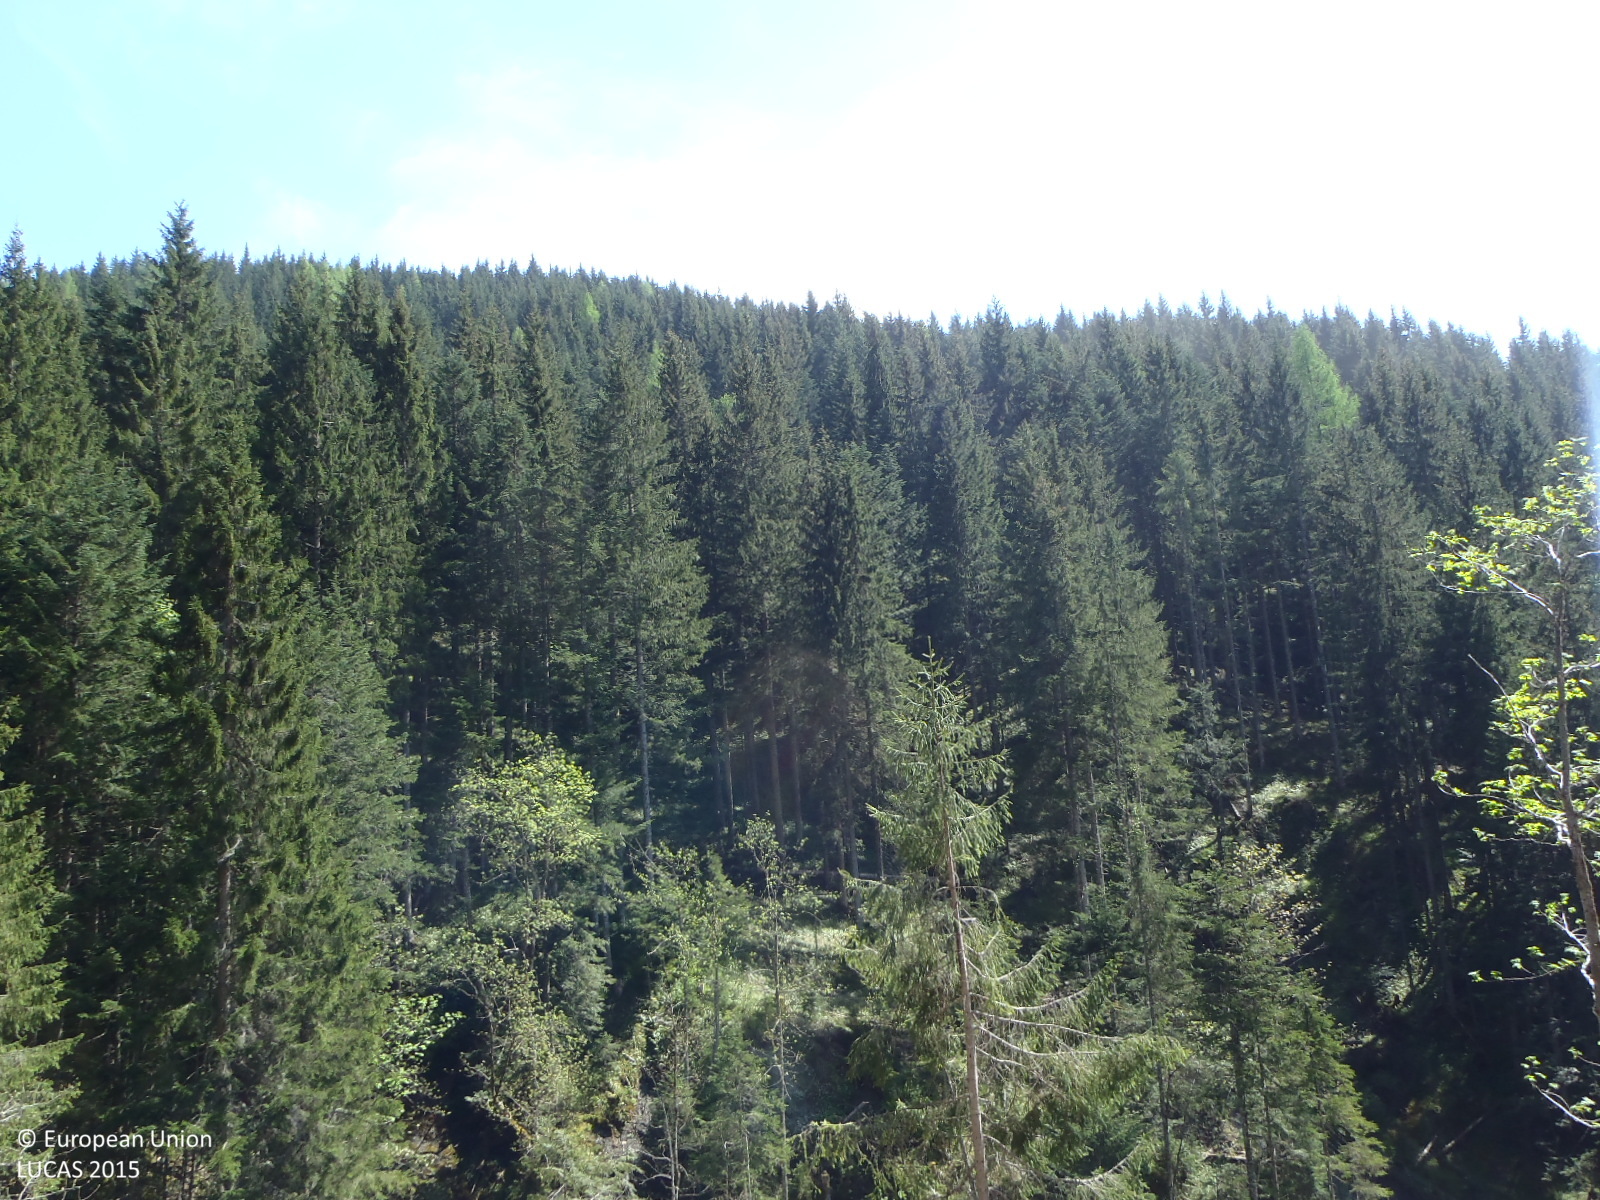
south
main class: Grassland
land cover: Spontaneously vegetated surfaces
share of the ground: 25 - 50 %
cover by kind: unconsolidated bare surface 65 %, herbaceous plants 30 %, shrubs 5 %
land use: Forestry
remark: Clear cut
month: May
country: AT
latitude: 47.3270
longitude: 13.3193
